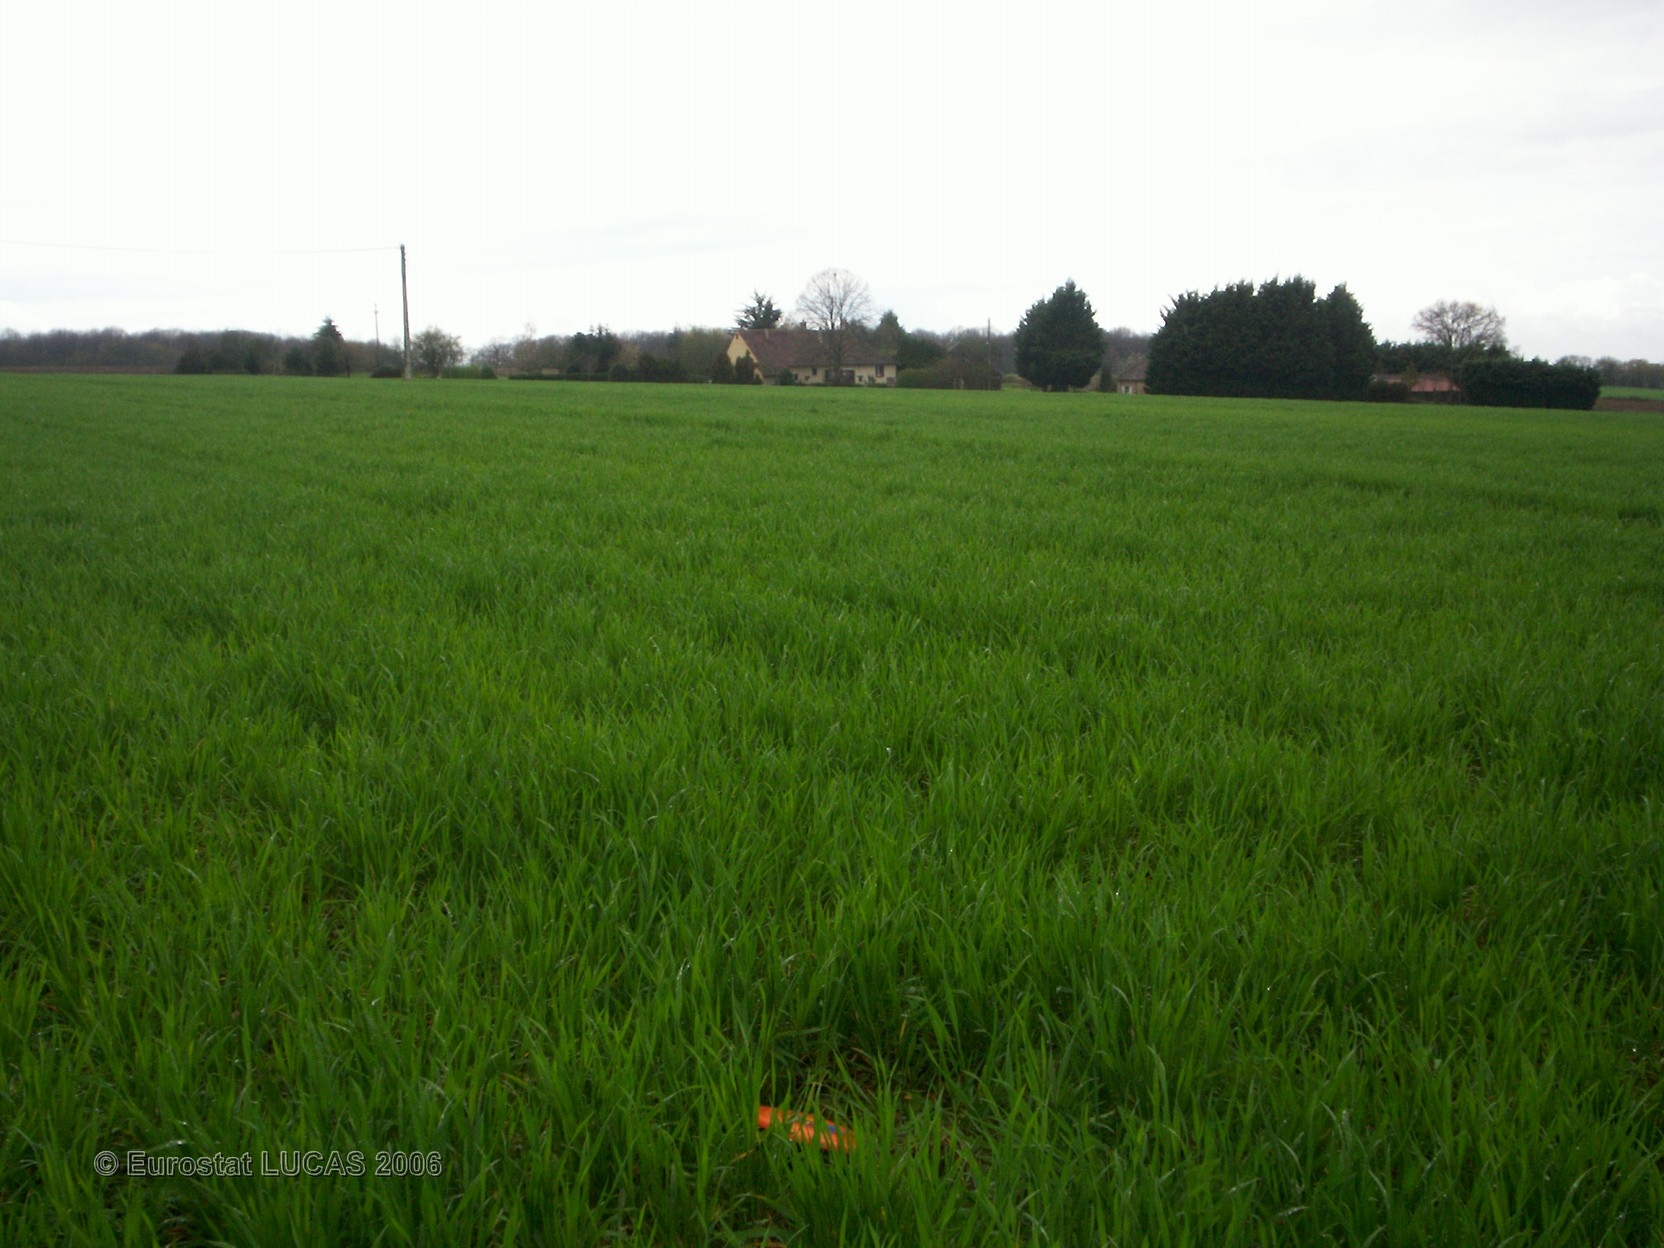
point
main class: Cropland
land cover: Barley
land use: Agriculture (excluding fallow land and kitchen gardens)
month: April
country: FR
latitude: 47.5147
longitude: 3.0229
